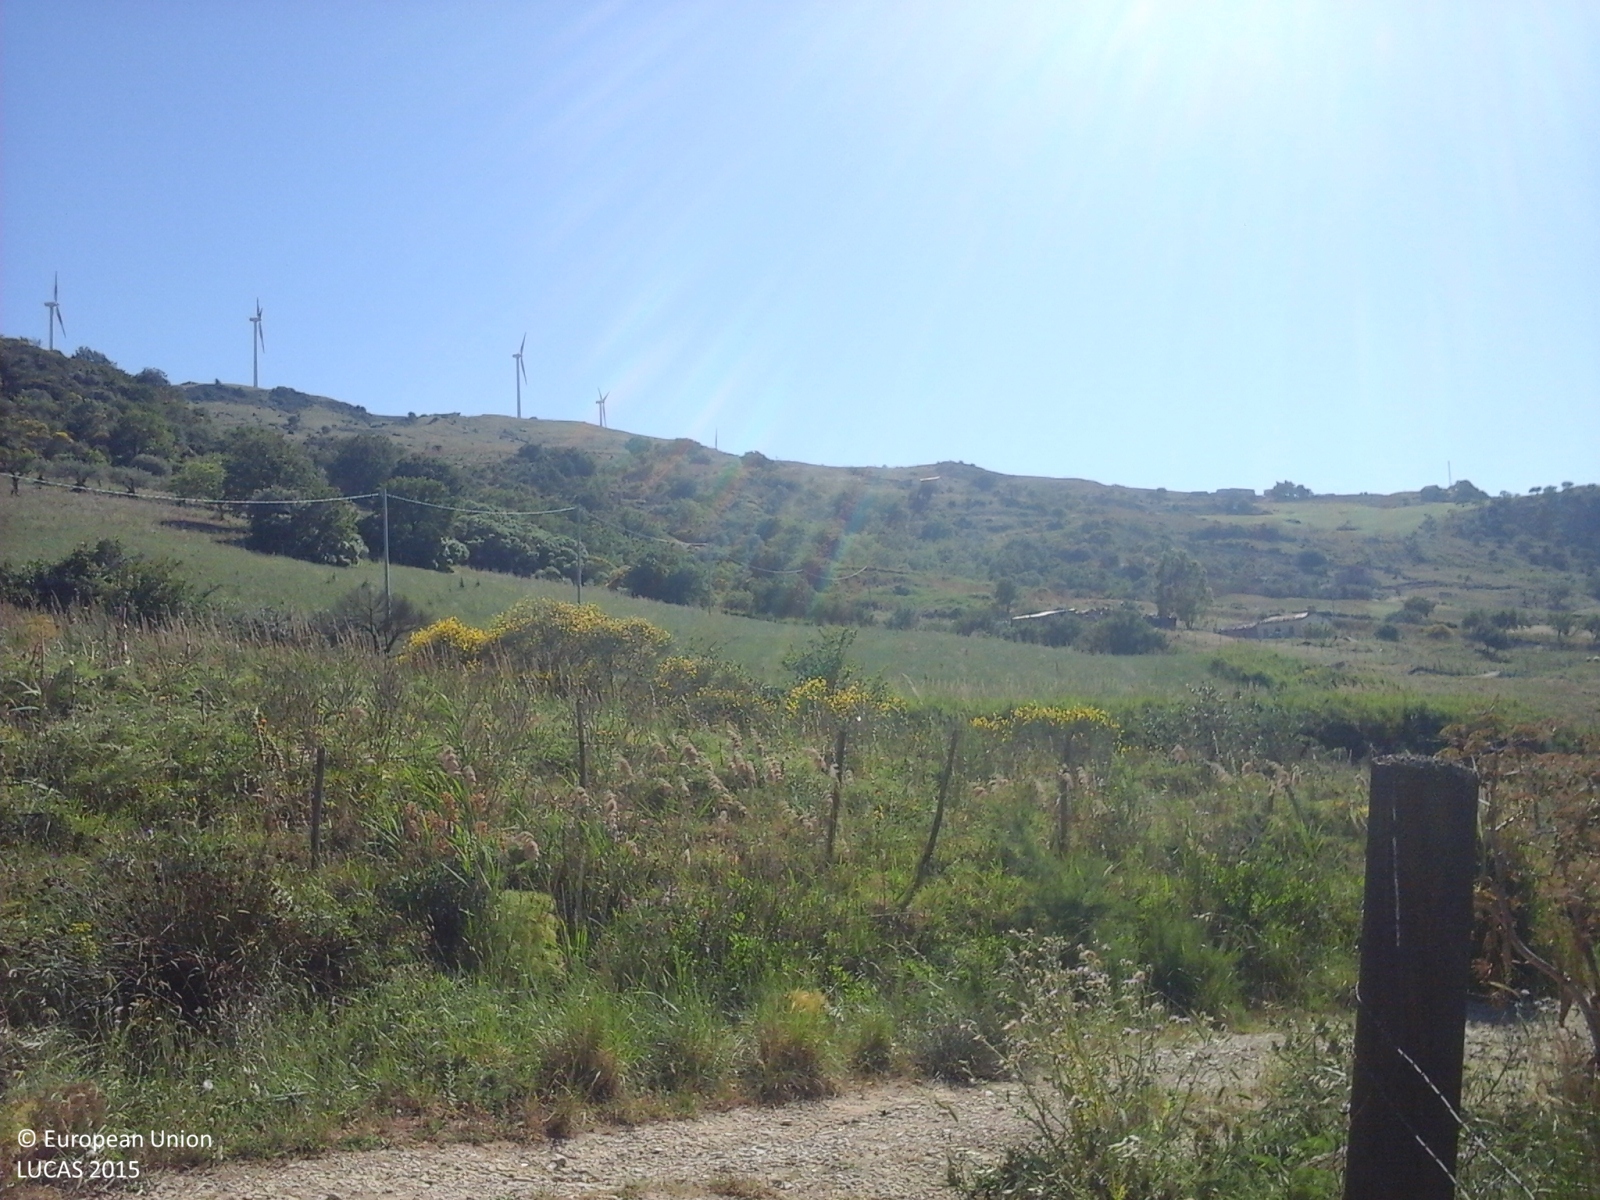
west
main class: Shrubland
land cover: Shrubland with sparse tree cover
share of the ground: > 75 %
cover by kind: herbaceous plants 55 %, shrubs 40 %, broadleaved forest trees 5 %
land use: Agriculture (excluding fallow land and kitchen gardens)
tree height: > 5 m
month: May
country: IT
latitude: 37.7171
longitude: 14.4268
